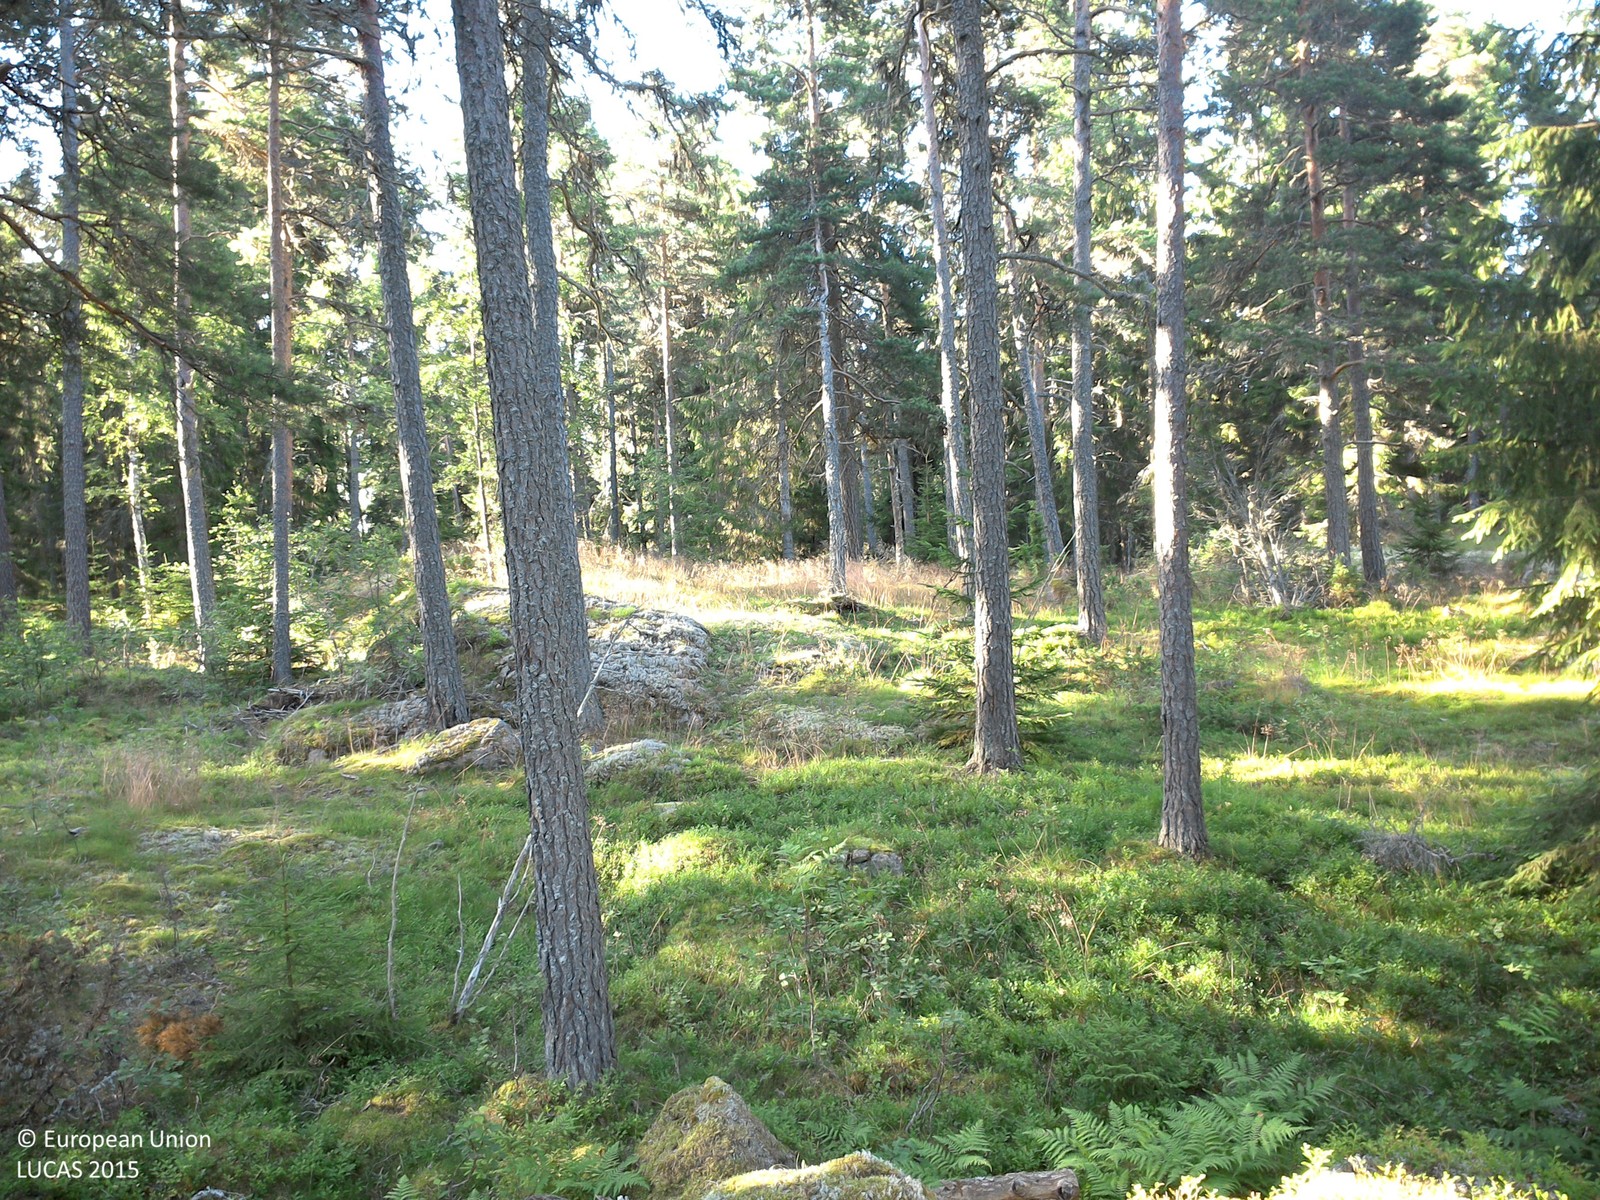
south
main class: Woodland
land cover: Pine dominated coniferous woodland
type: boreal forest
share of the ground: 50 - 75 %
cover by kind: coniferous forest trees 60 %, lichens and mosses 25 %, herbaceous plants 15 %
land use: Forestry
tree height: > 5 m
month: July
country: SE
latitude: 58.2402
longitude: 15.3262
